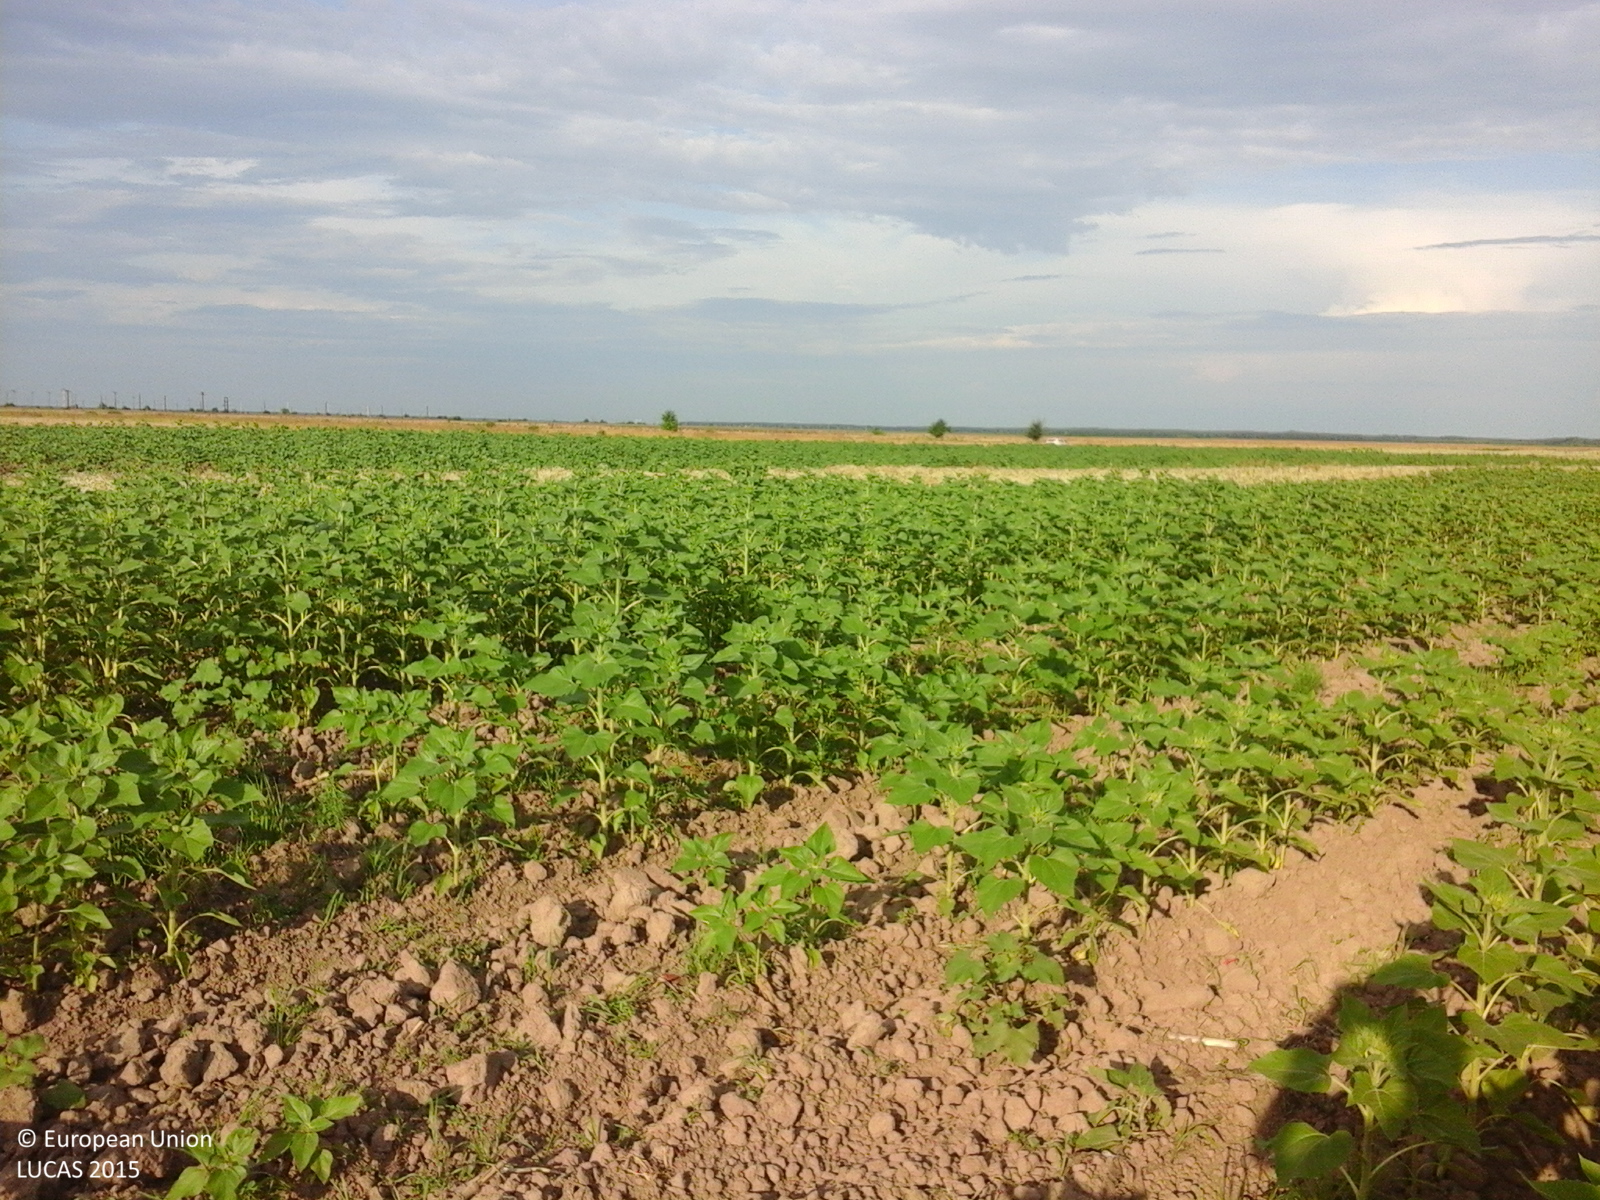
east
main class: Cropland
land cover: Sunflower
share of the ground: 50 - 75 %
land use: Agriculture (excluding fallow land and kitchen gardens)
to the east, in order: Sunflower; Tracks; Common wheat; Sunflower
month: July
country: RO
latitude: 44.3999
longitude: 25.4193
